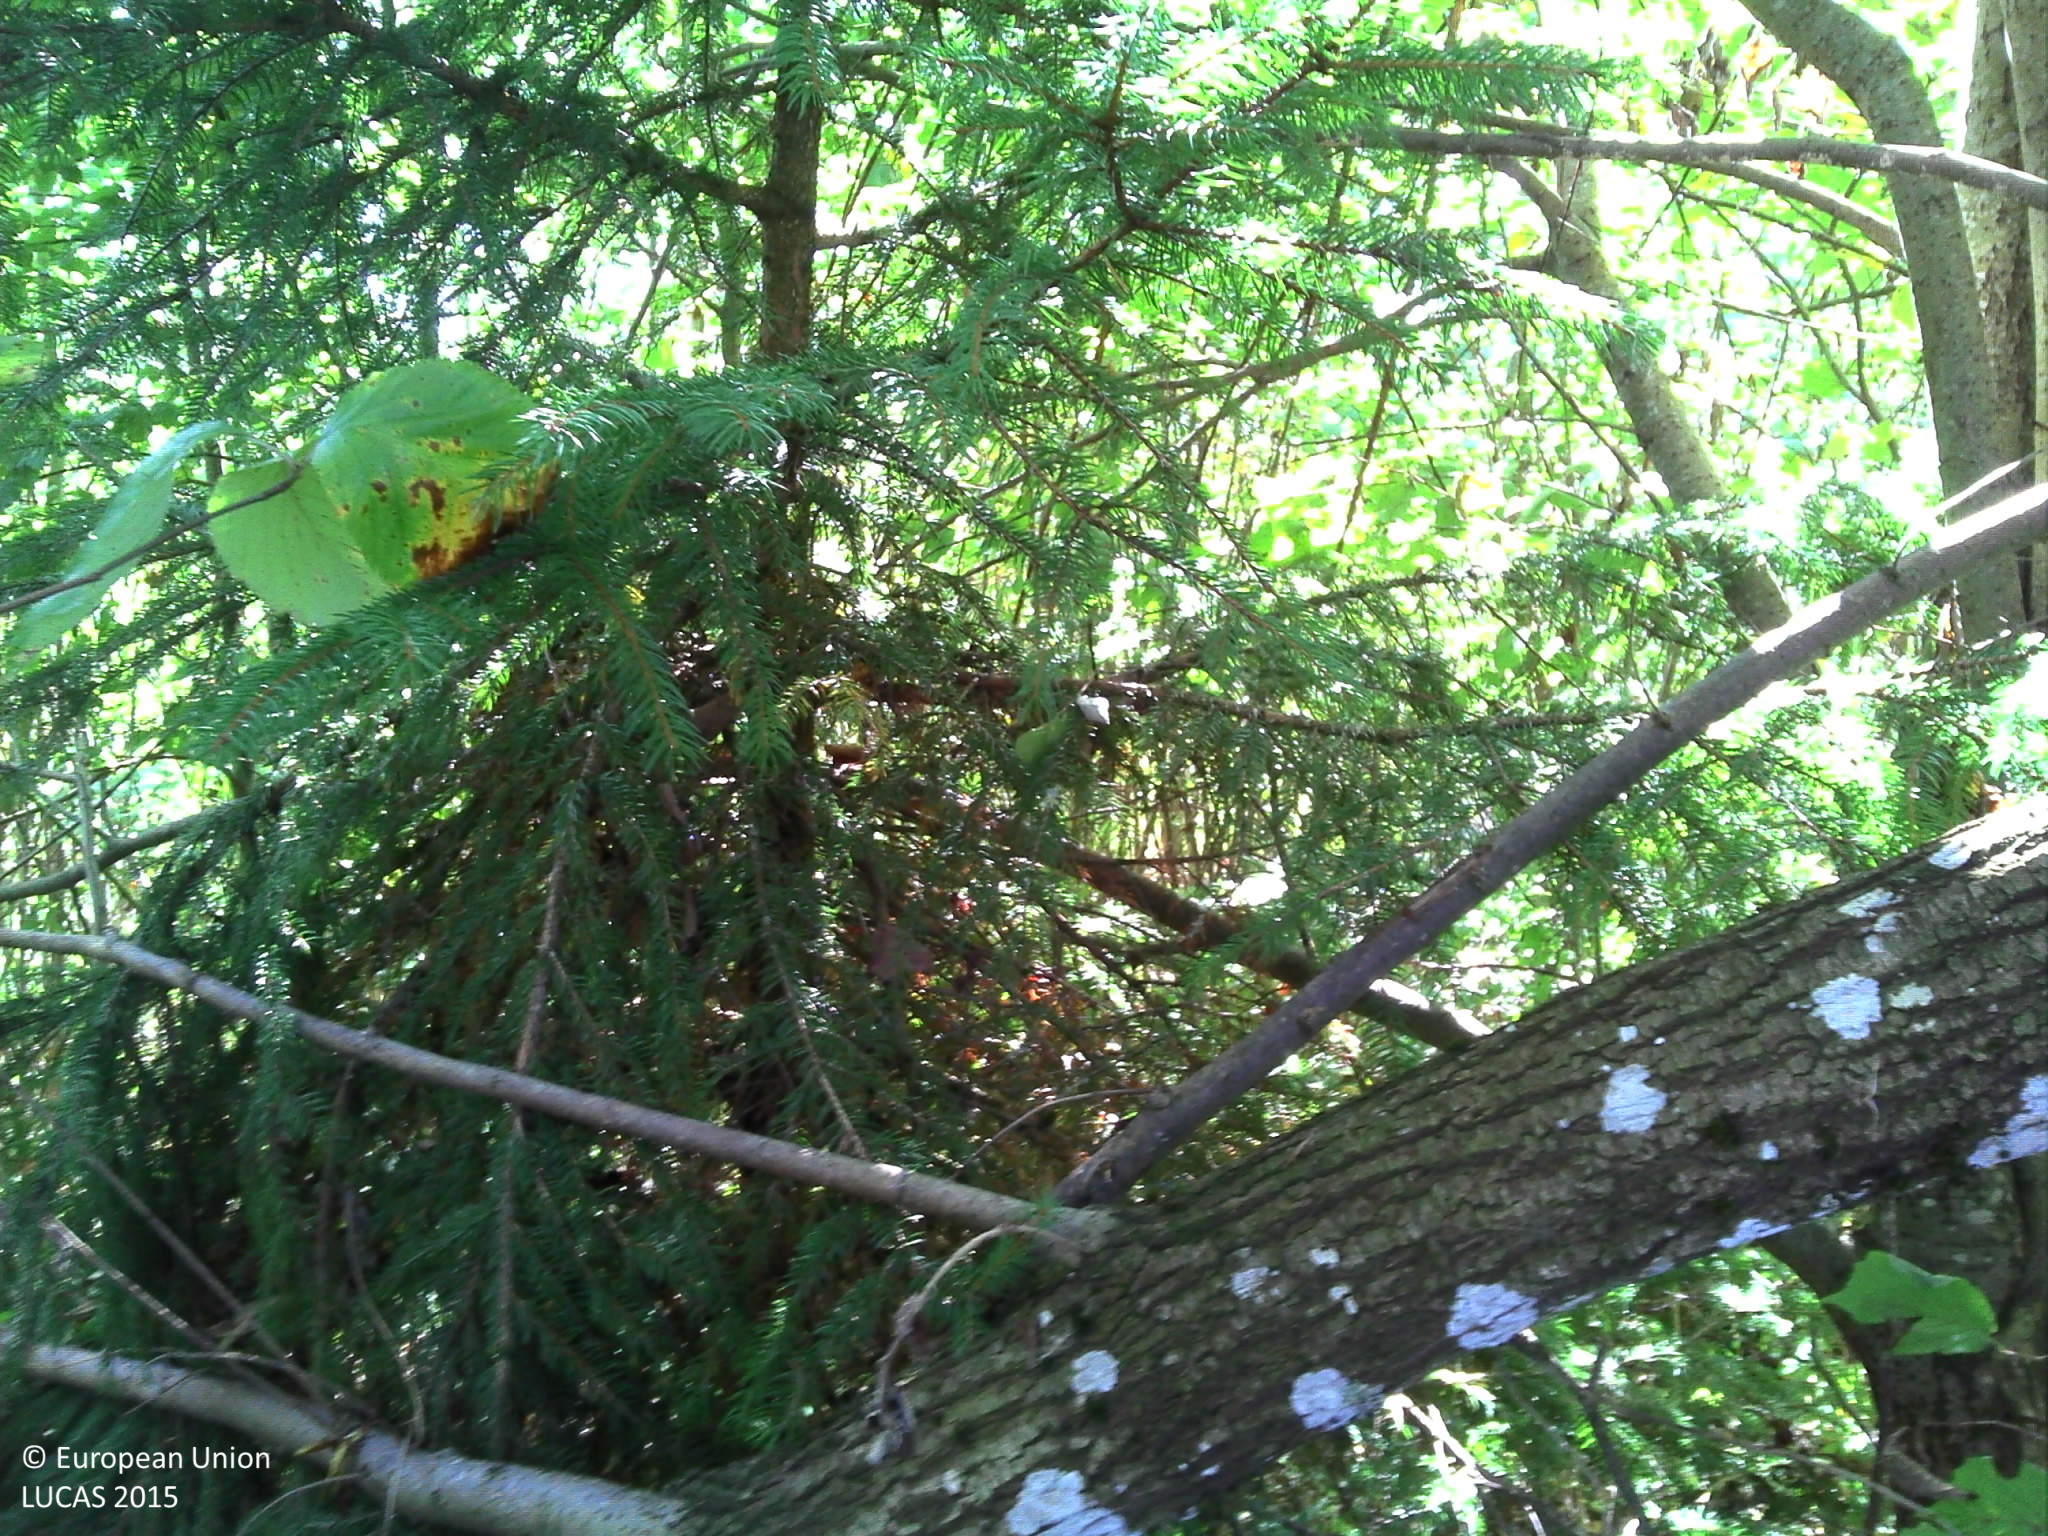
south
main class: Grassland
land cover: Grassland without tree/shrub cover
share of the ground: > 75 %
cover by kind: herbaceous plants 100 %
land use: Agriculture (excluding fallow land and kitchen gardens)
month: September
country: FR
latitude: 47.2238
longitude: 6.8457
